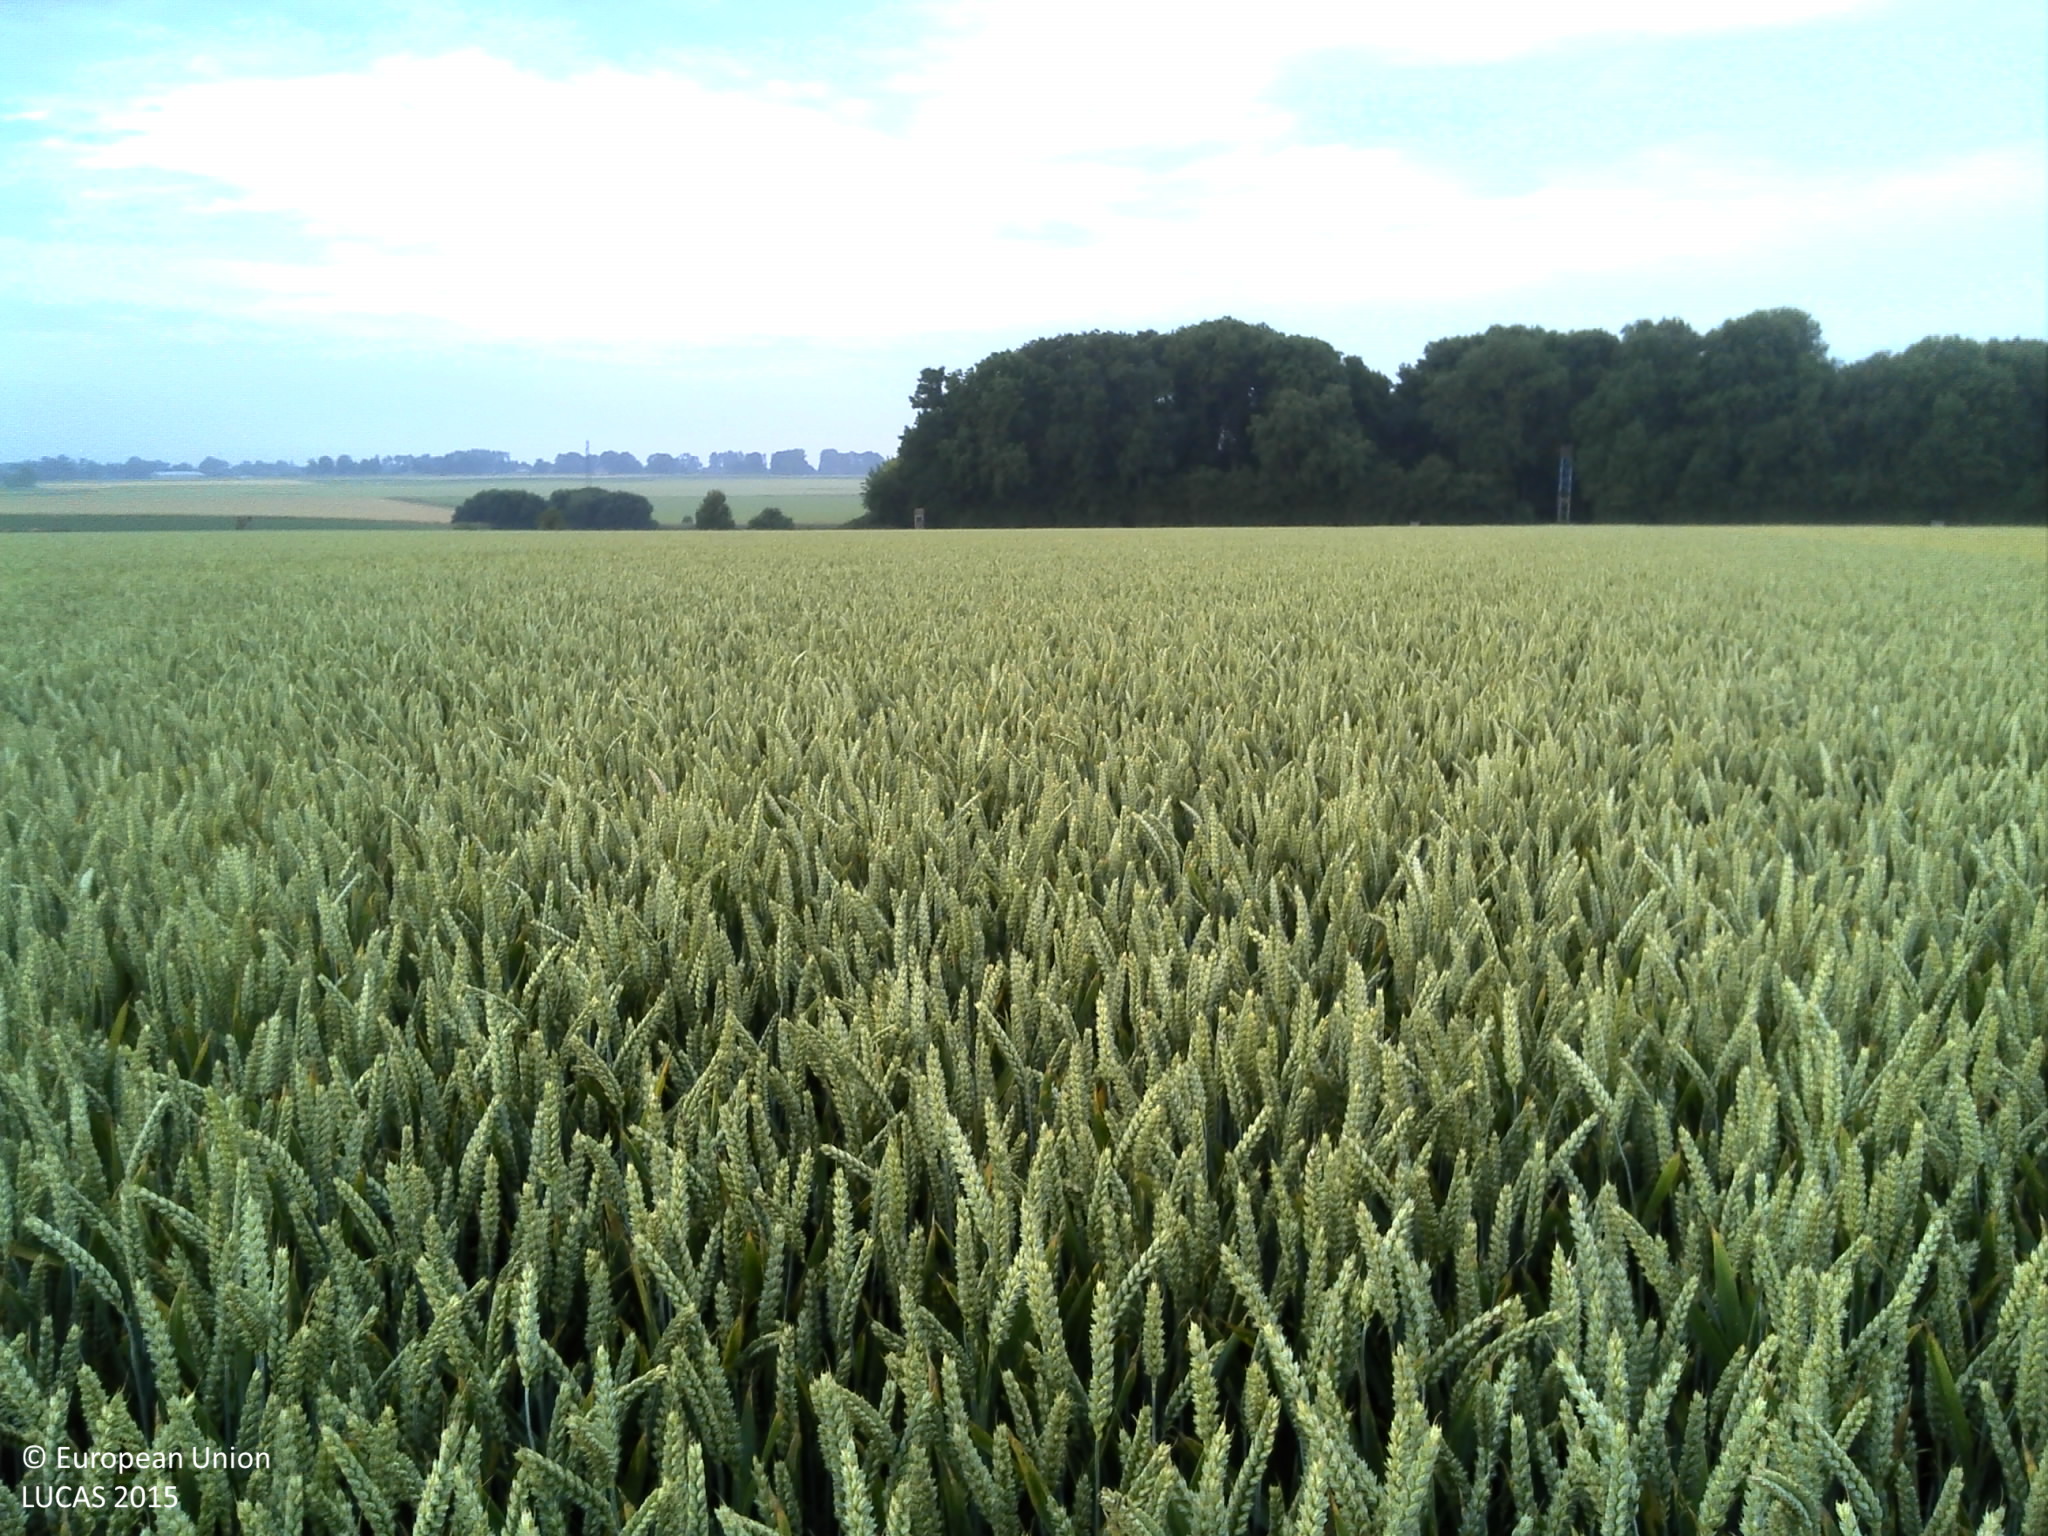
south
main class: Cropland
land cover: Common wheat
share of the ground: > 75 %
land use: Agriculture (excluding fallow land and kitchen gardens)
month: July
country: FR
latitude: 49.8754
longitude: 0.9179
